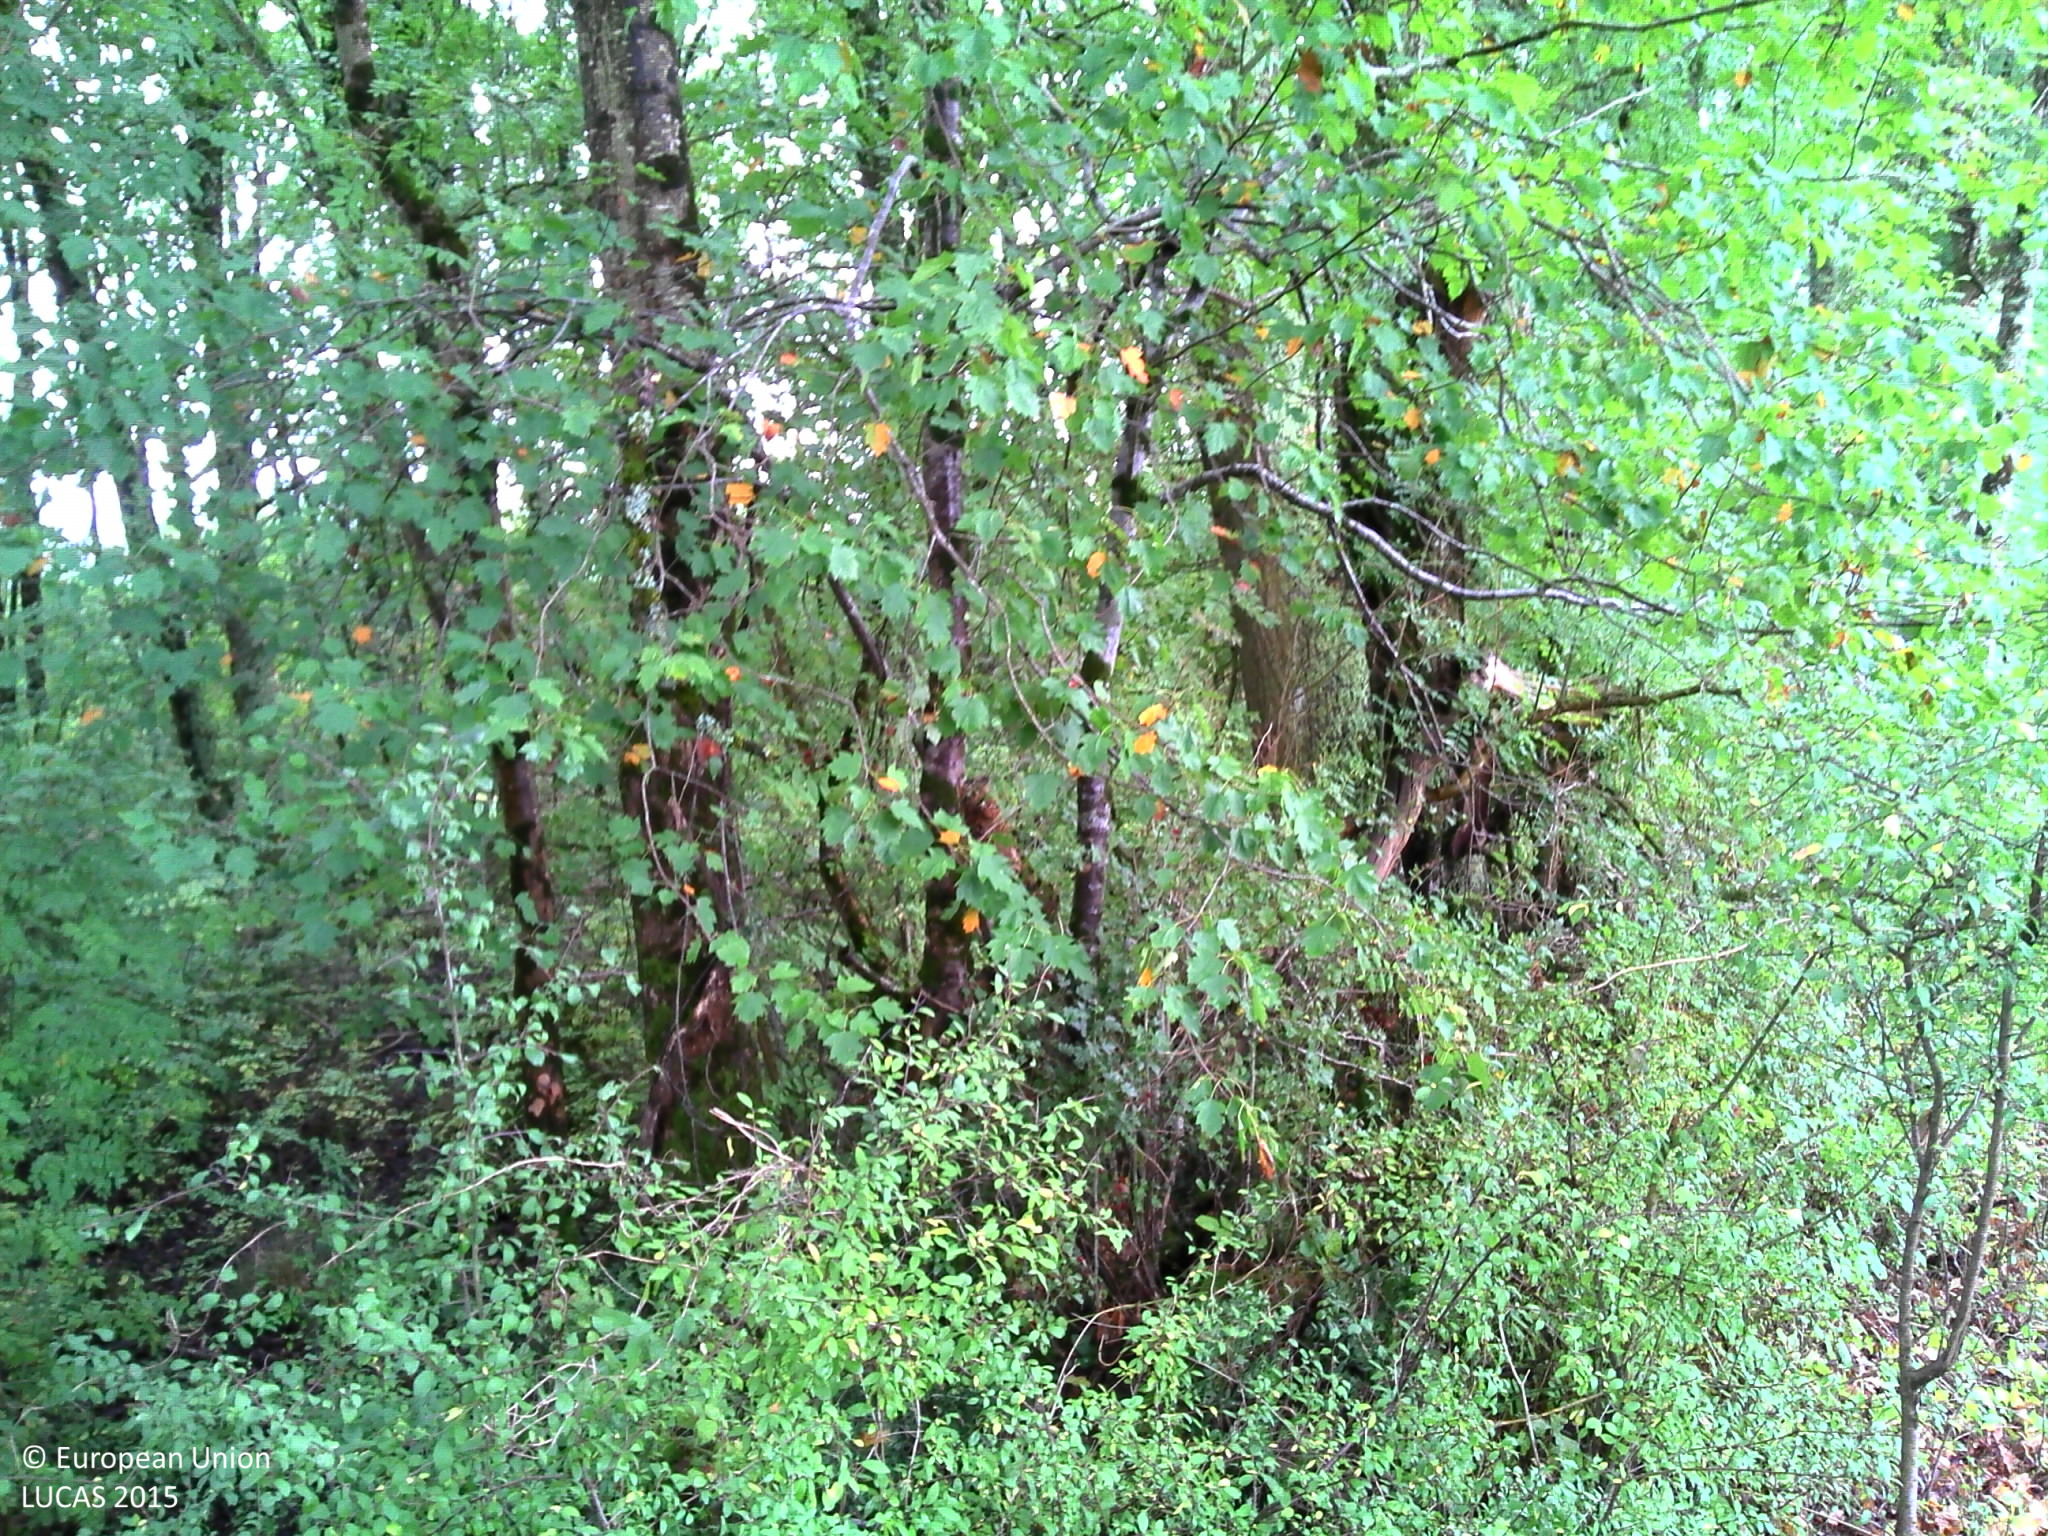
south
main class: Grassland
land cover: Grassland without tree/shrub cover
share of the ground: > 75 %
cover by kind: herbaceous plants 100 %
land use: Agriculture (excluding fallow land and kitchen gardens)
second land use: Amenities, museums, leisure
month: September
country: FR
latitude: 46.4924
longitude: 1.1673
